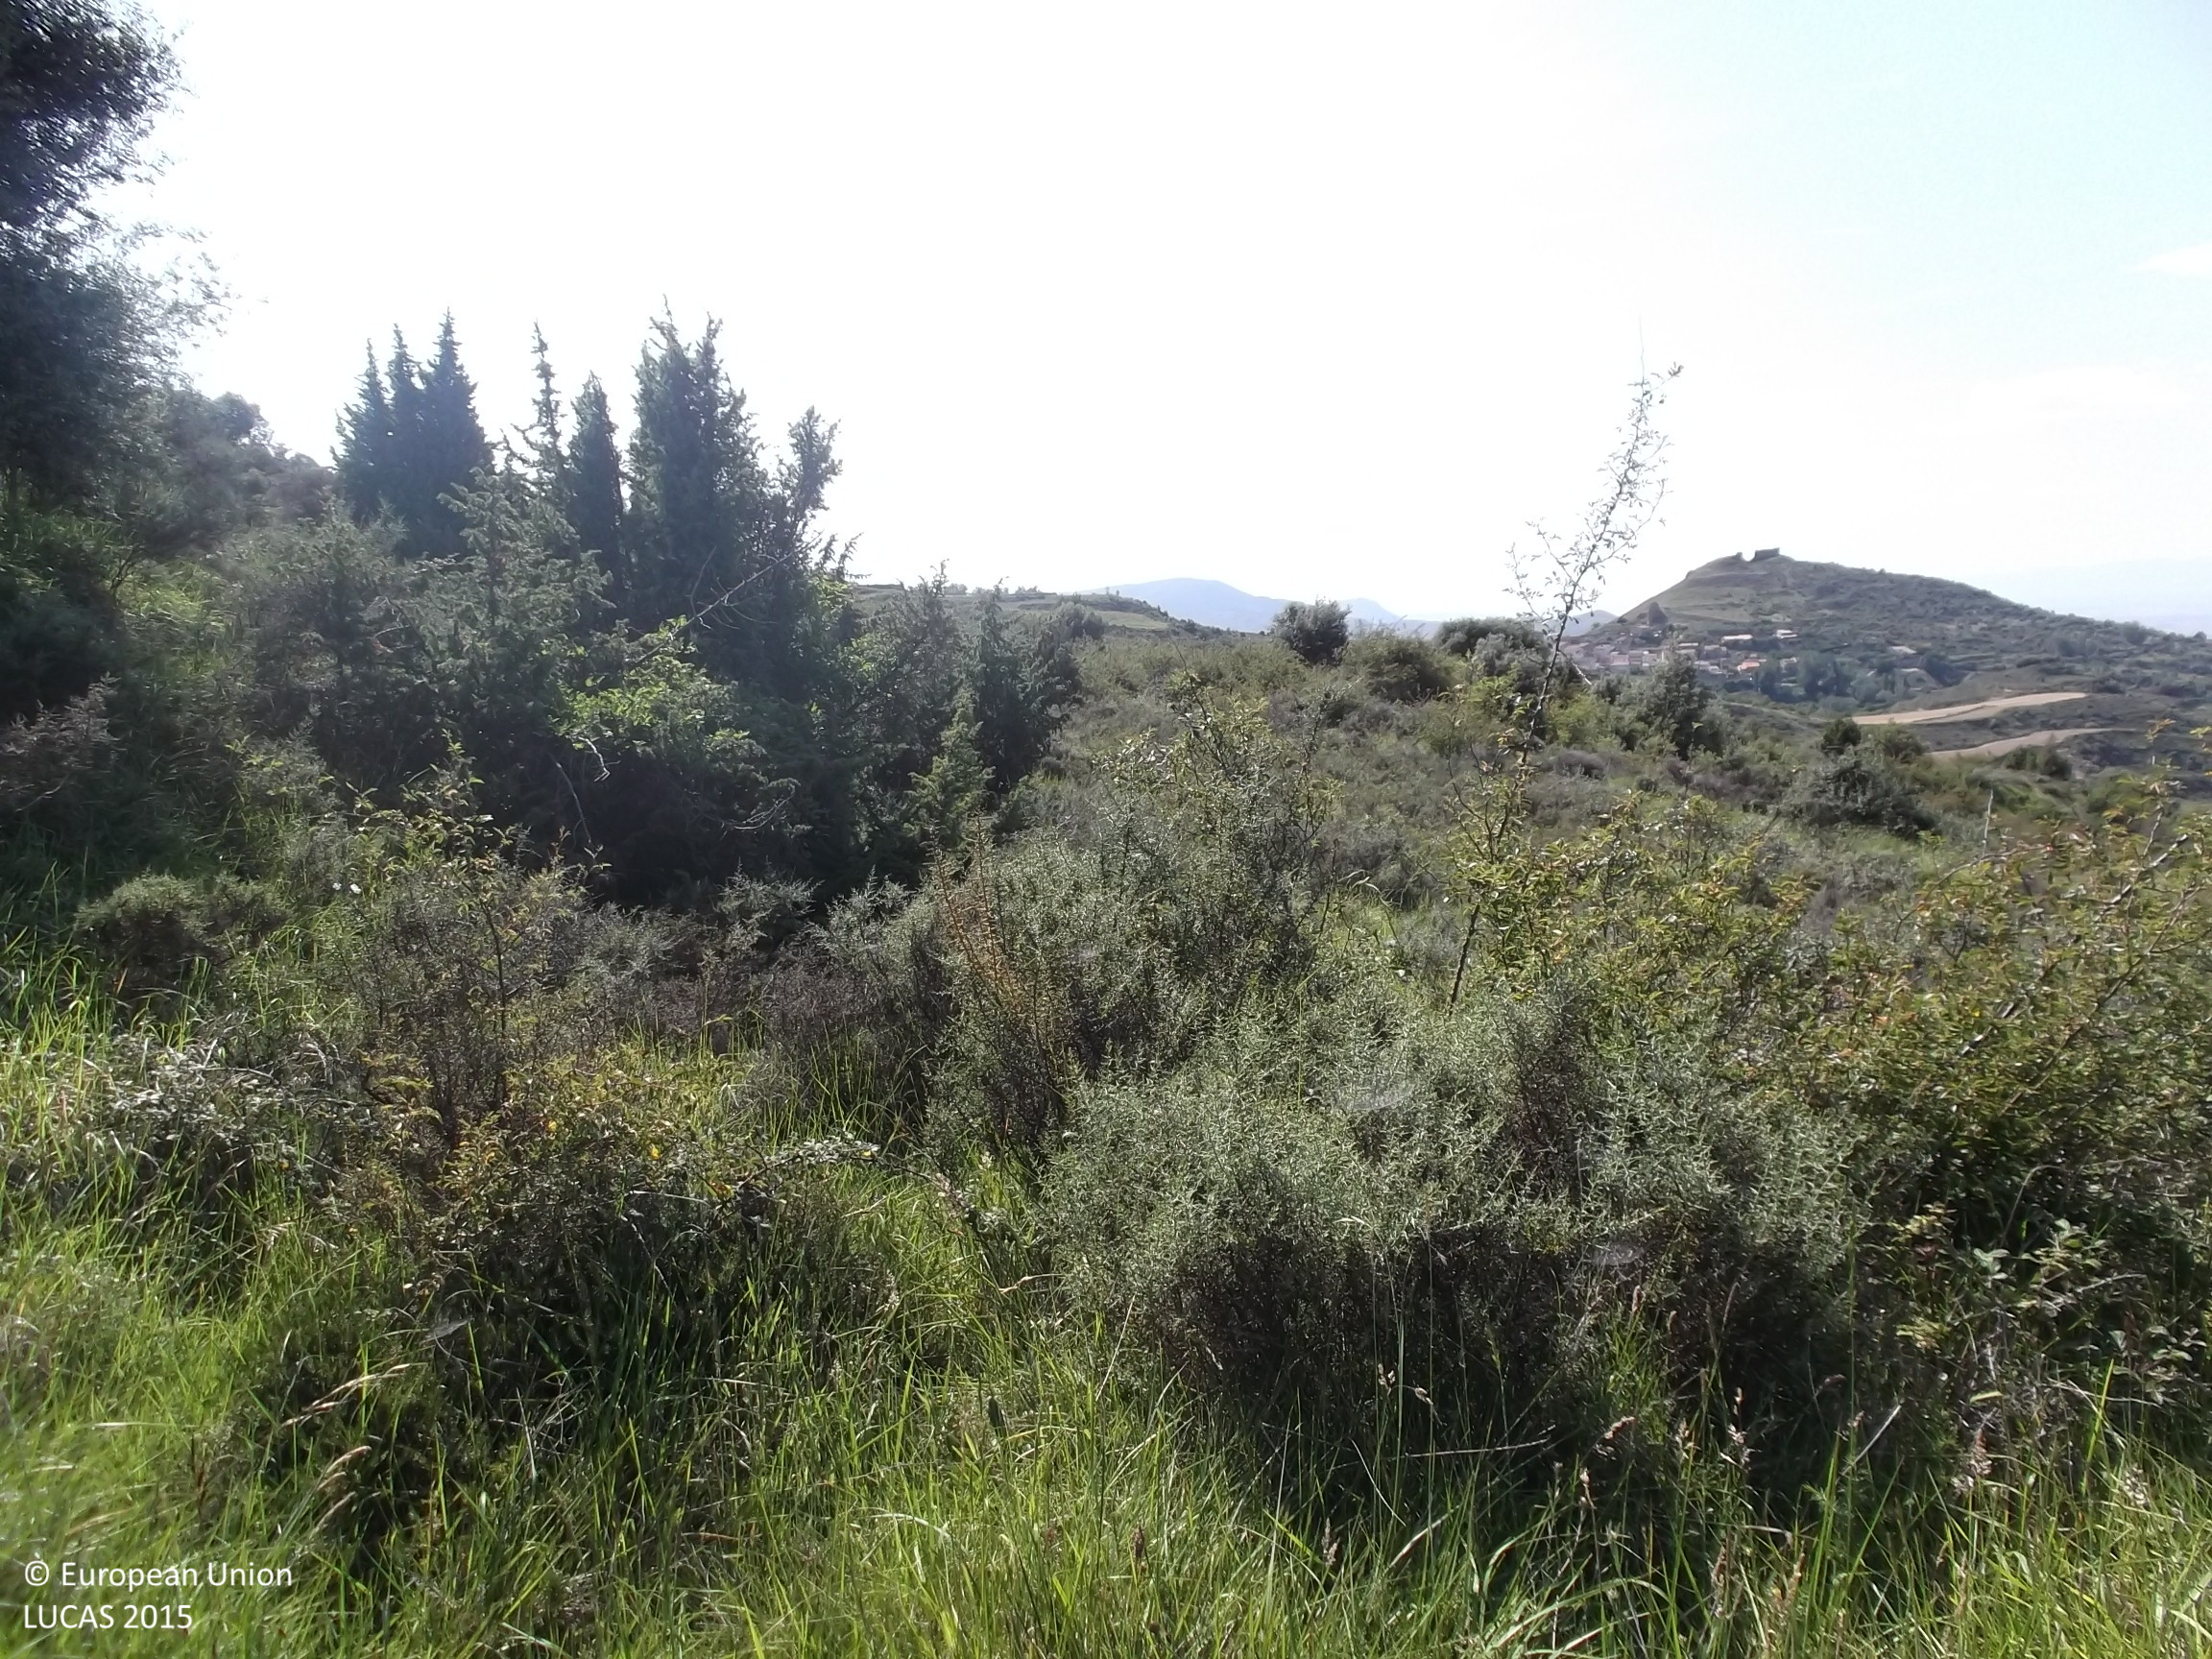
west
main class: Woodland
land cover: Broadleaved woodland
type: broadleaved evergreen forest
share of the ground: 10 - 25 %
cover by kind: shrubs 50 %, herbaceous plants 30 %, broadleaved forest trees 15 %, coniferous forest trees 5 %
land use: Semi-natural and natural areas not in use
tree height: > 5 m
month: June
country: ES
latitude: 42.2931
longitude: -2.2298
